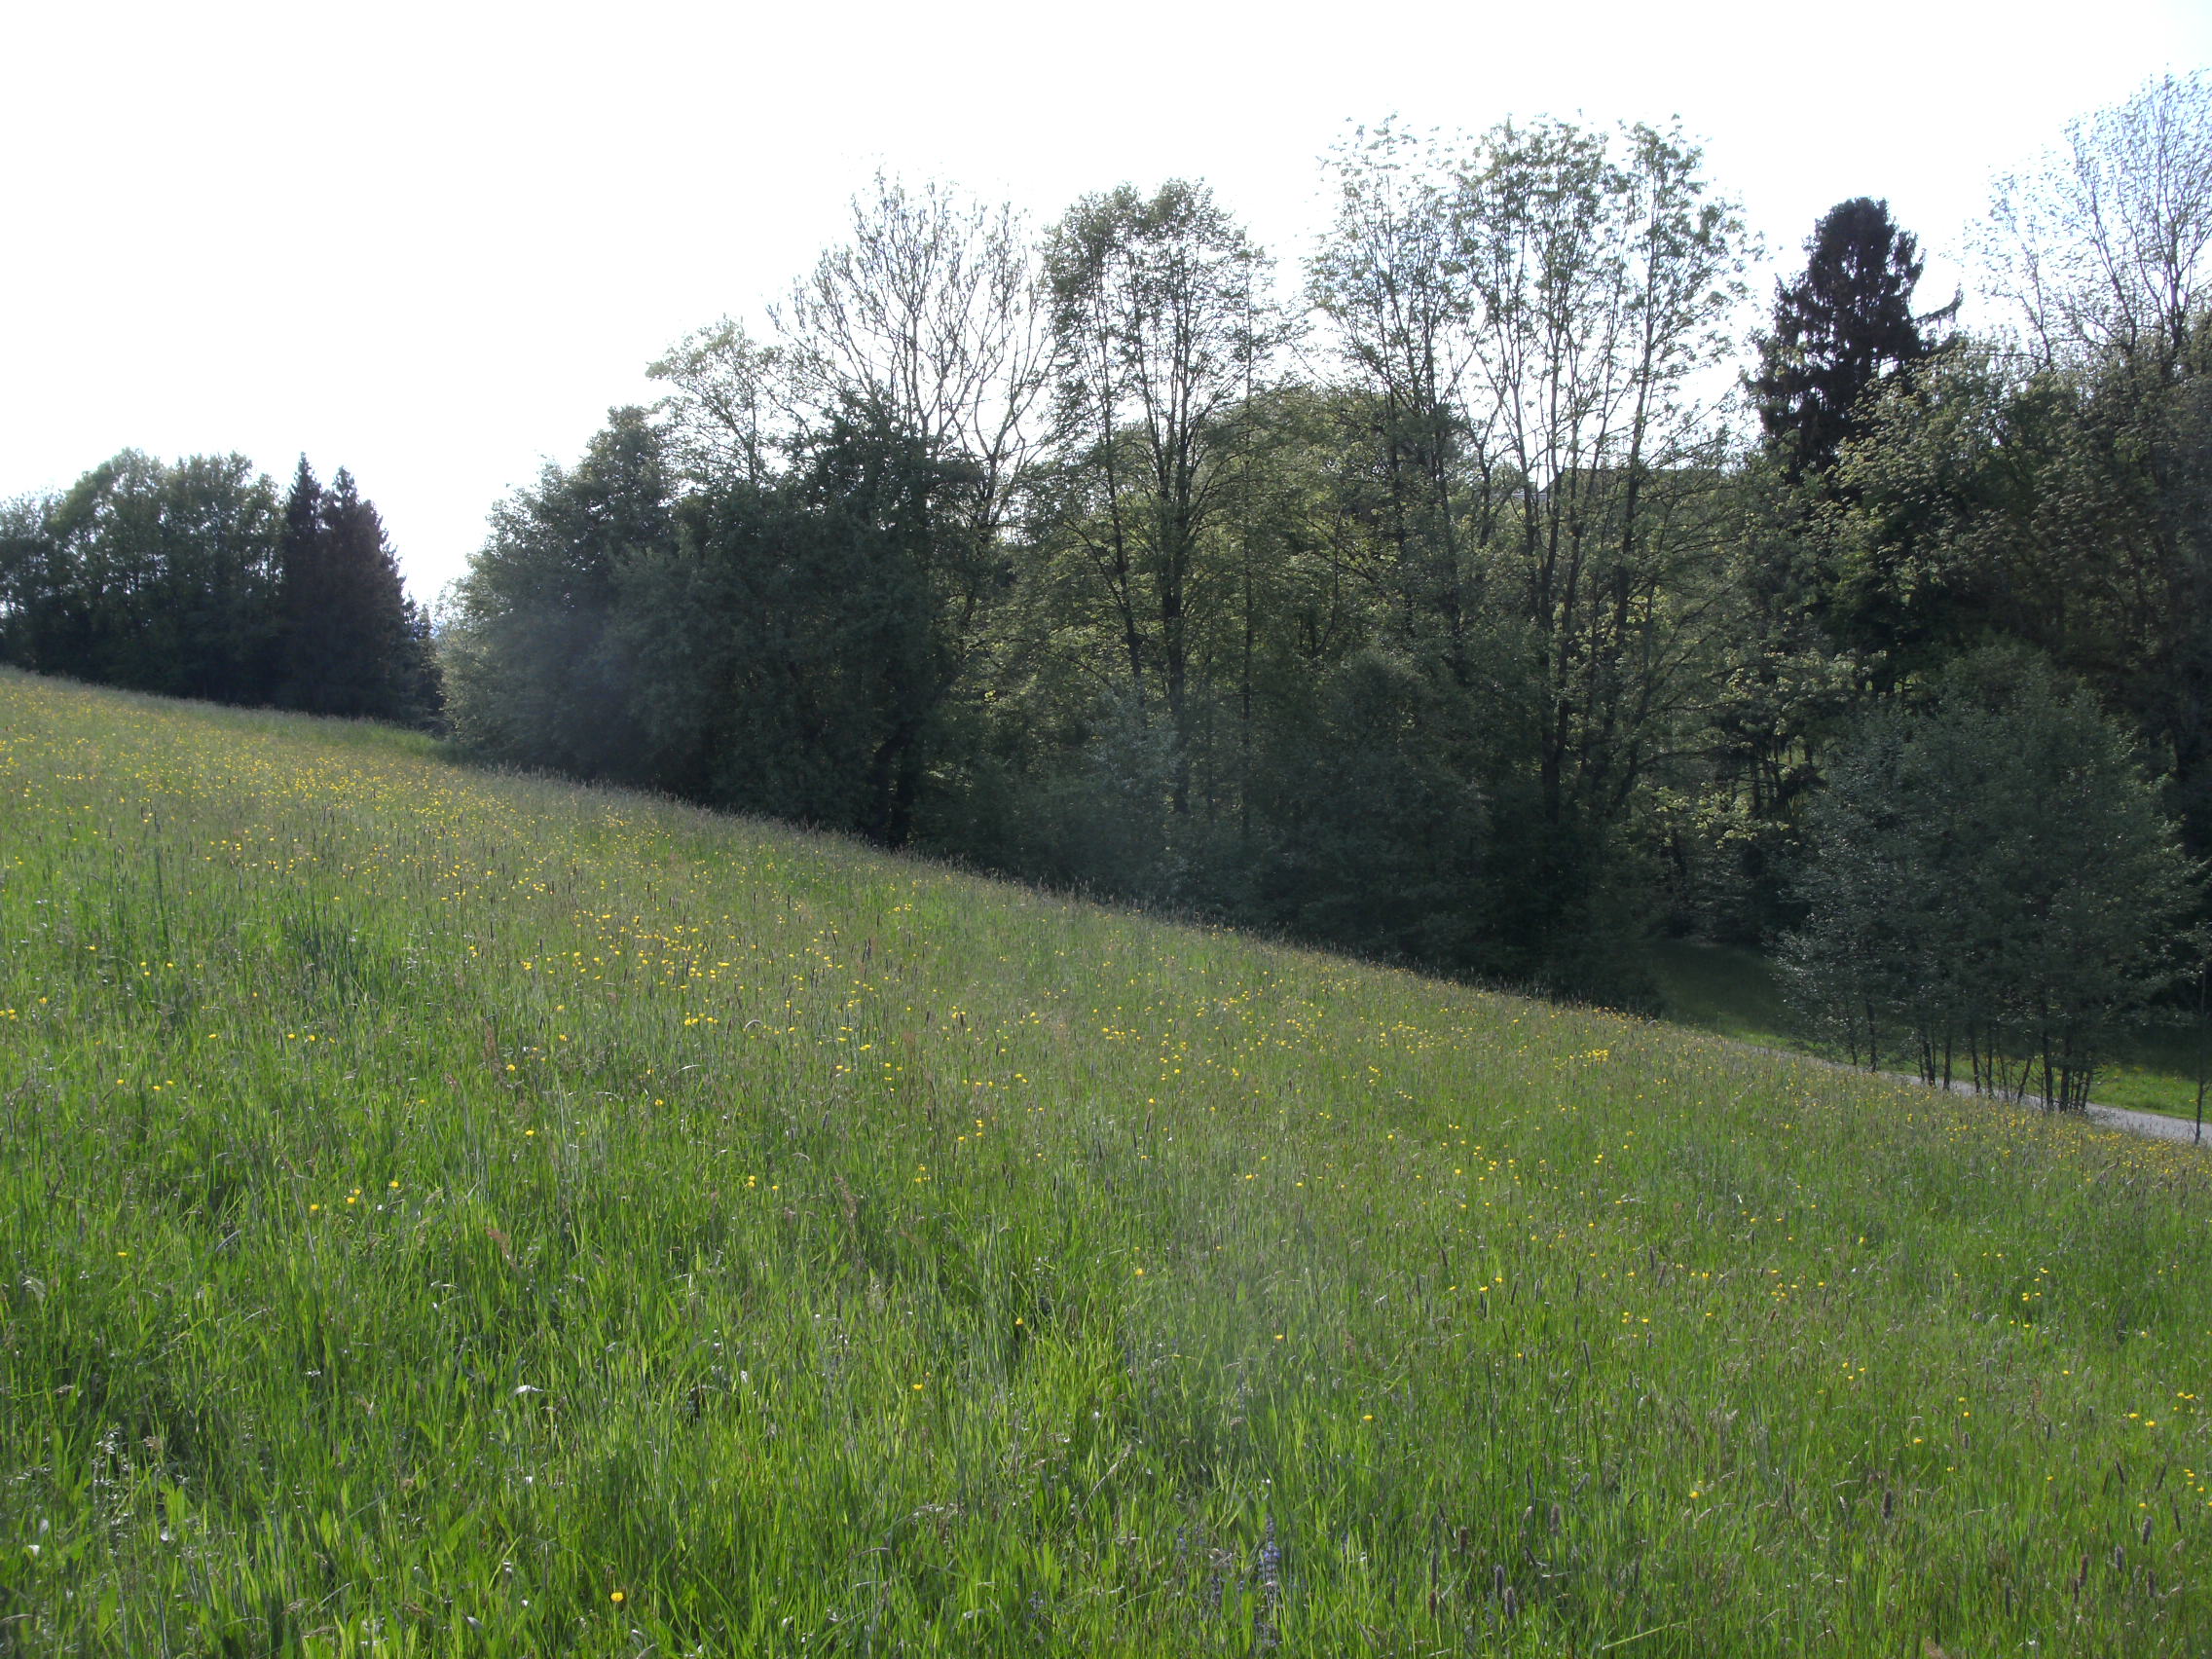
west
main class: Grassland
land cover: Grassland without tree/shrub cover
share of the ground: > 75 %
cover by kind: herbaceous plants 100 %
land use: Agriculture (excluding fallow land and kitchen gardens)
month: May
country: AT
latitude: 48.4921
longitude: 13.5042
